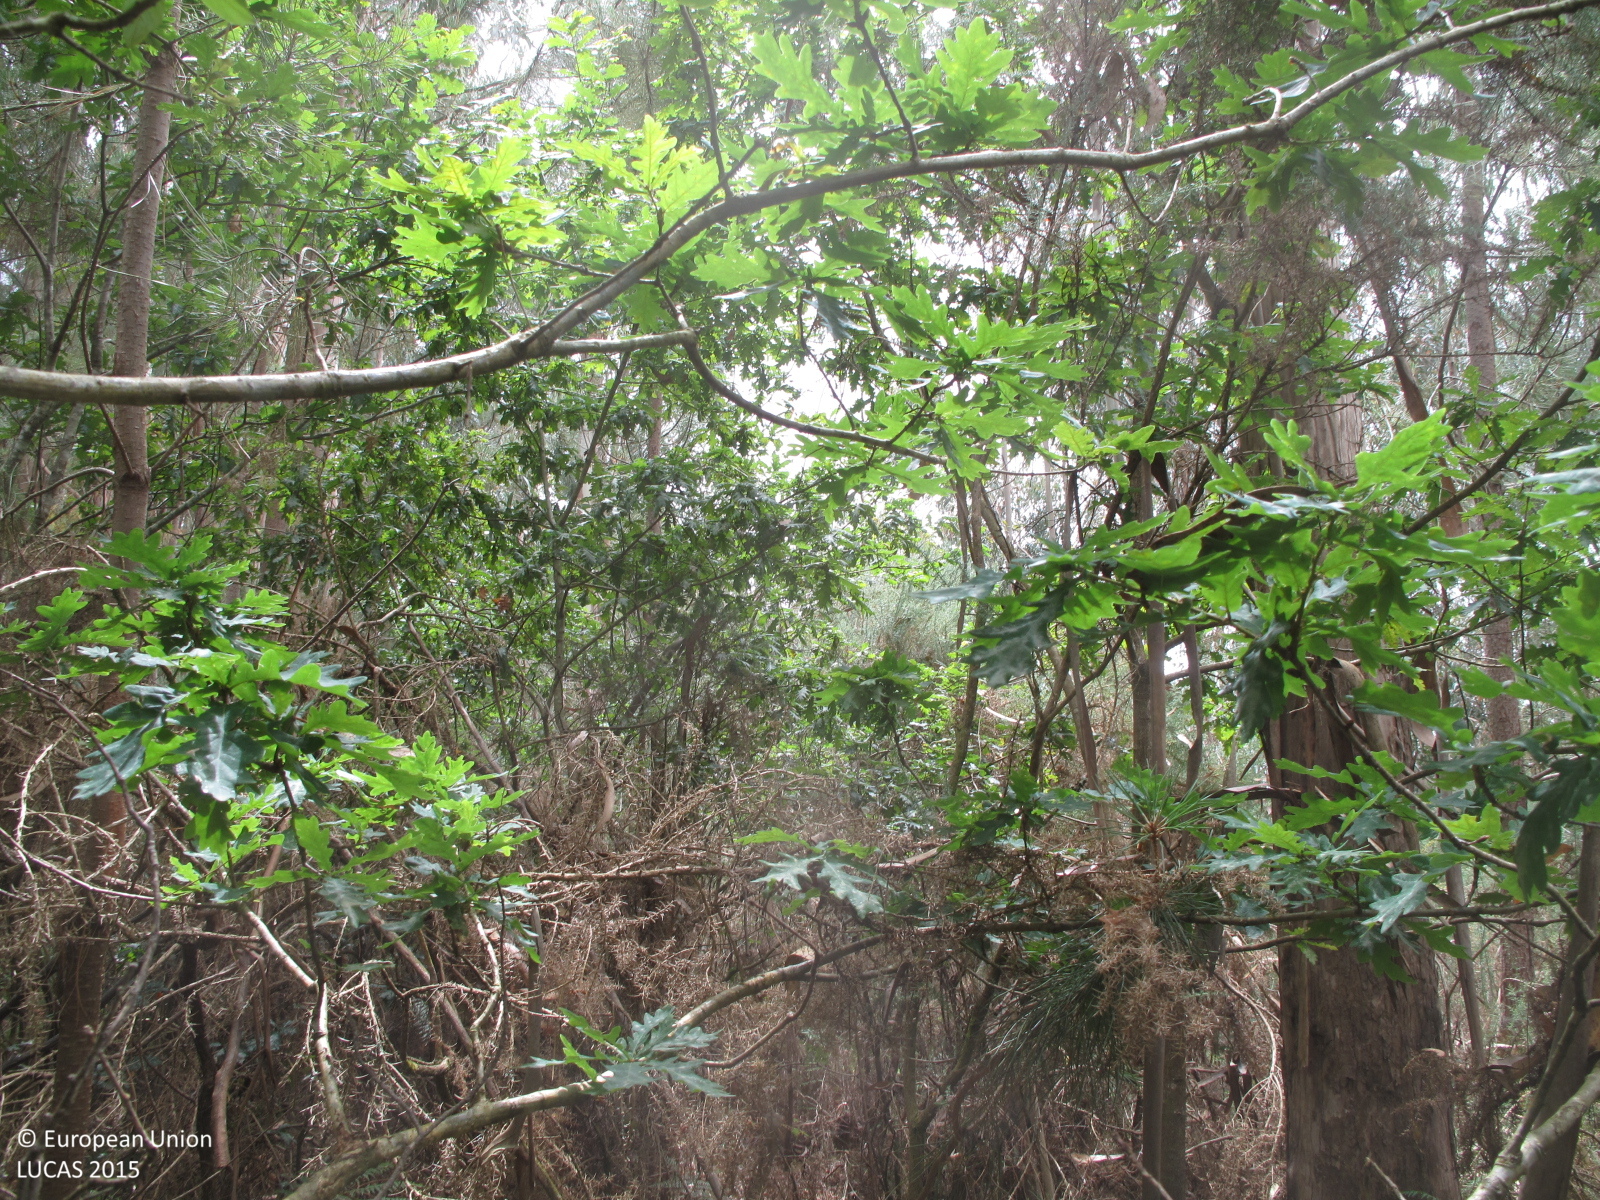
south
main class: Woodland
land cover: Broadleaved woodland
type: exotic forest
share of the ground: 50 - 75 %
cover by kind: broadleaved forest trees 70 %, shrubs 30 %
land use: Forestry
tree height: > 5 m
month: July
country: ES
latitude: 43.4740
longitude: -8.1363
